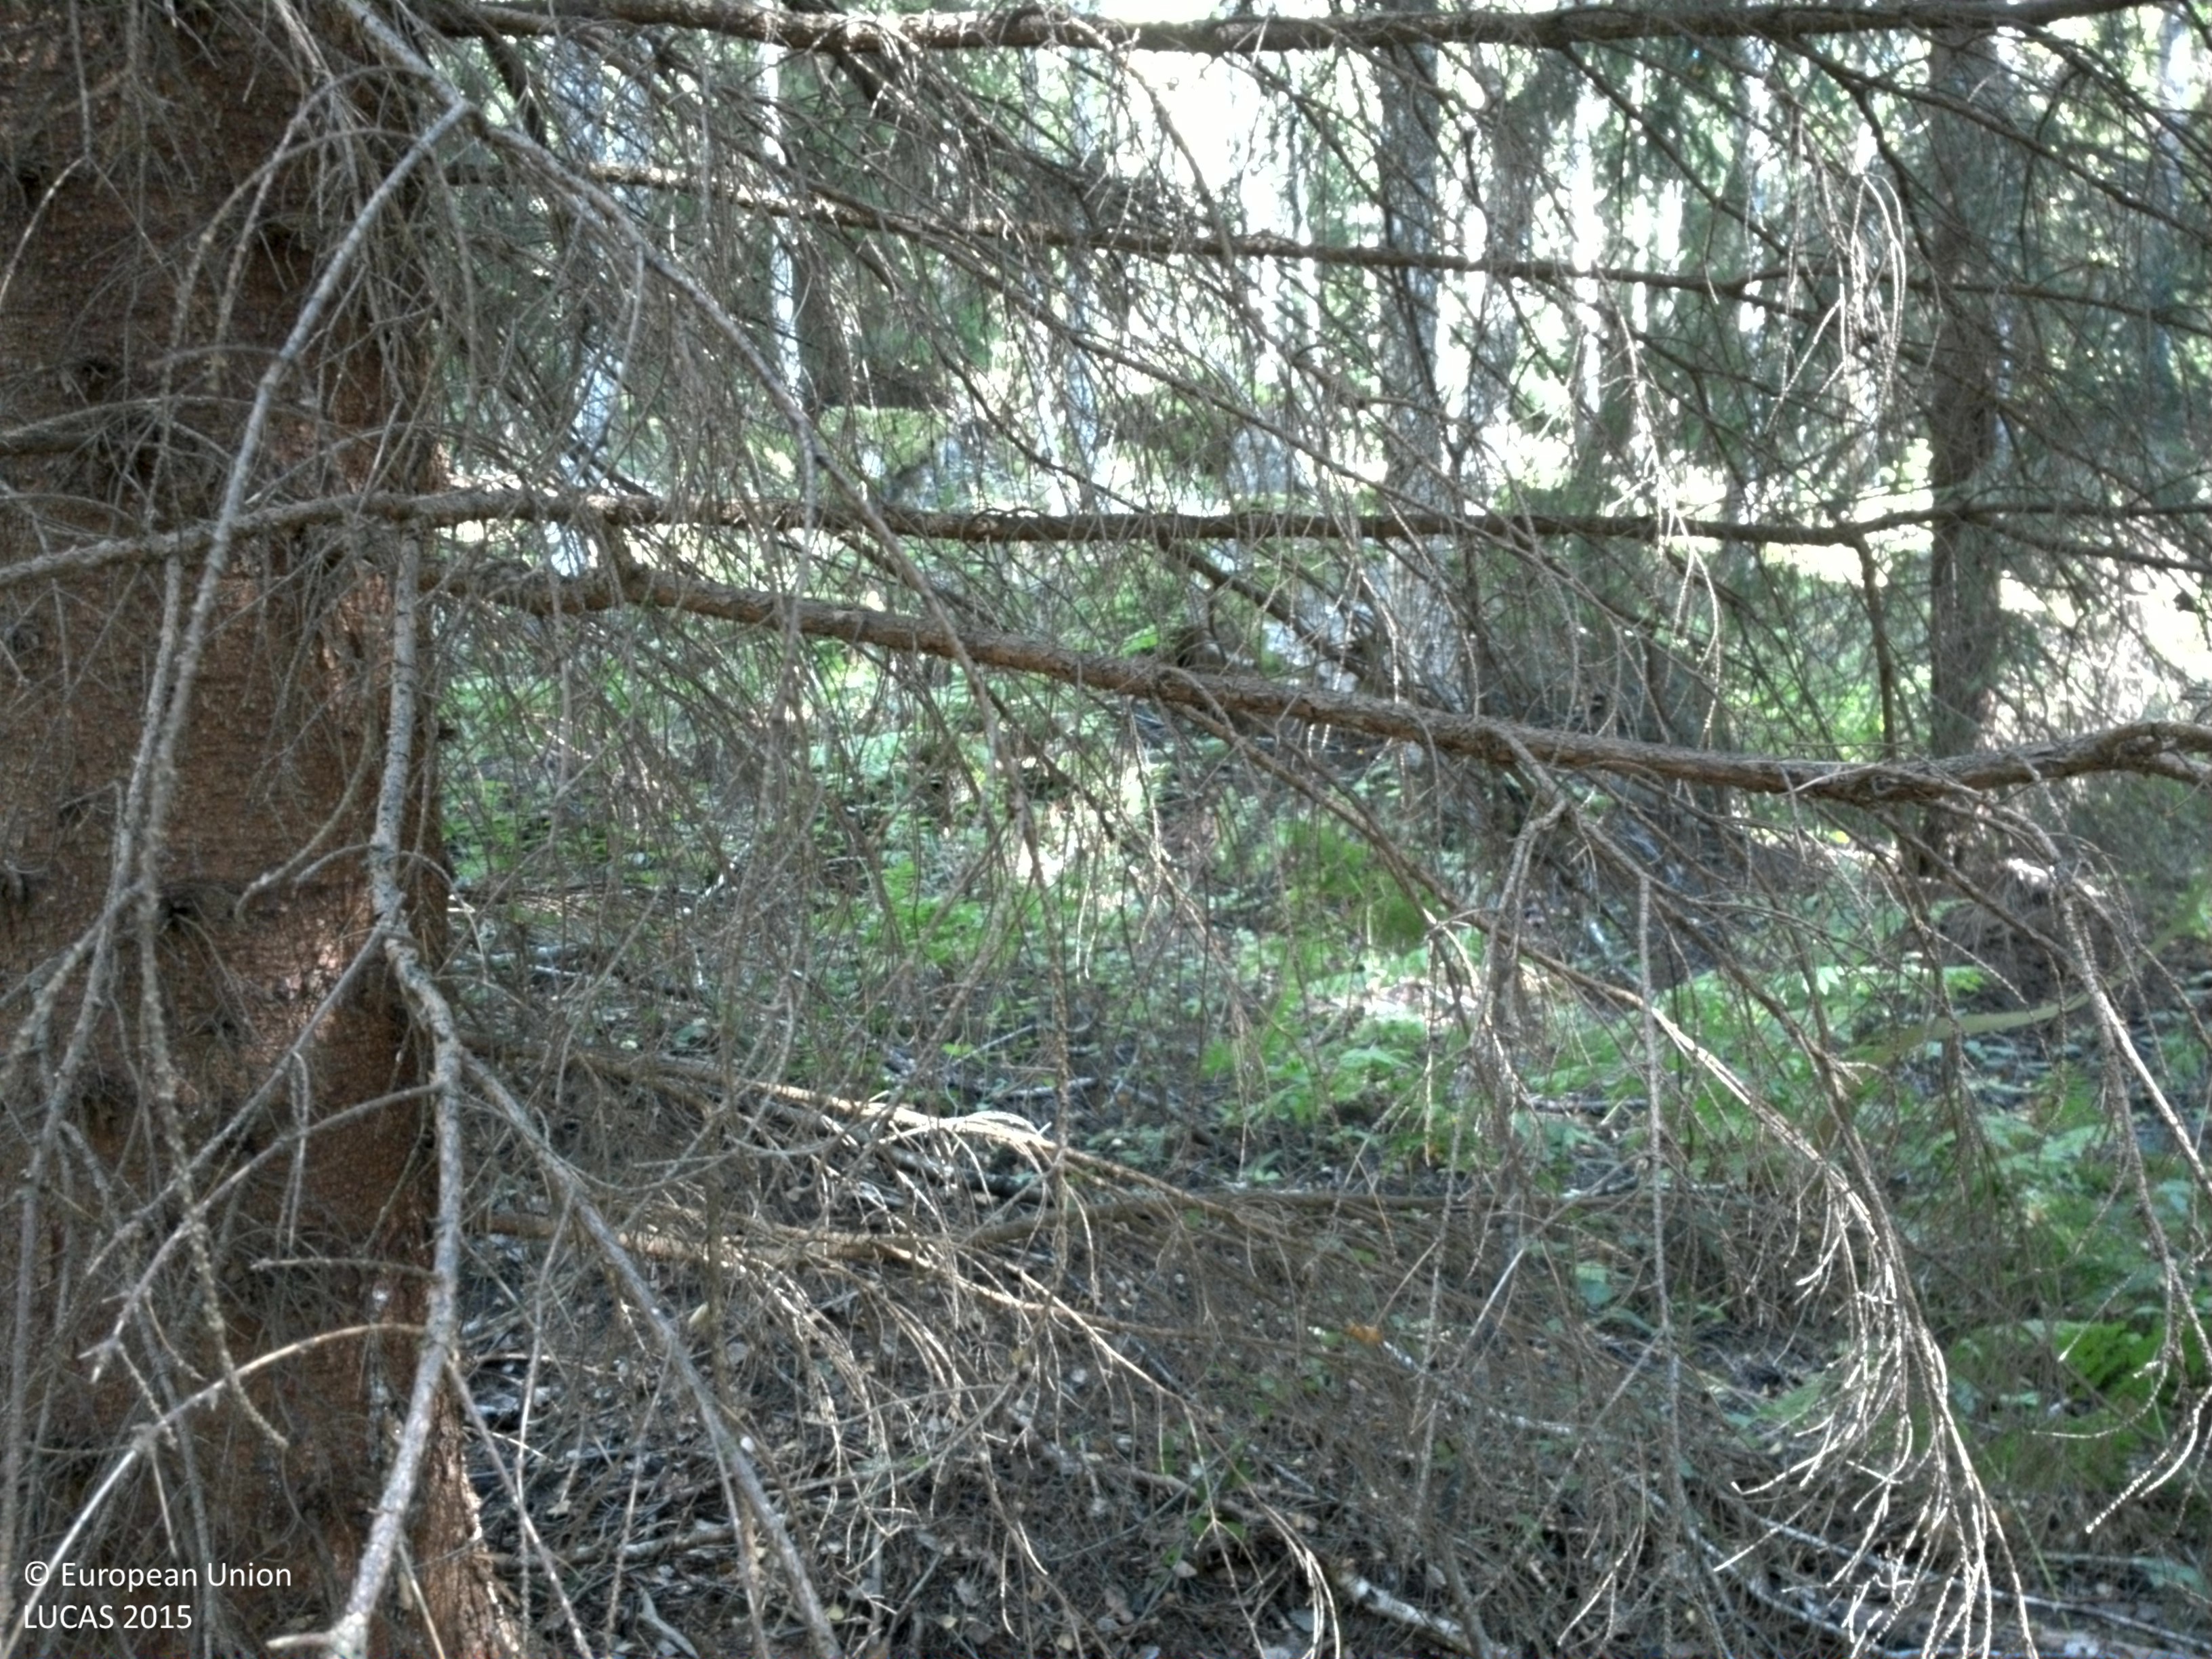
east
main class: Woodland
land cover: Spruce dominated coniferous woodland
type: boreal forest
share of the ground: > 75 %
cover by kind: coniferous forest trees 80 %, broadleaved forest trees 5 %, herbaceous plants 5 %, lichens and mosses 5 %, unconsolidated bare surface 5 %
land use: Forestry
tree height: > 5 m
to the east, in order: Spruce dominated coniferous woodland; Spruce dominated mixed woodland; Pine dominated coniferous woodland; Pine dominated mixed woodland; Broadleaved woodland; Grassland without tree/shrub cover; Paved roads, cycling and walking lanes; Ditches and canals; Other coniferous woodland; Spruce dominated coniferous woodland
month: August
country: SE
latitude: 59.9753
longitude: 17.9322
